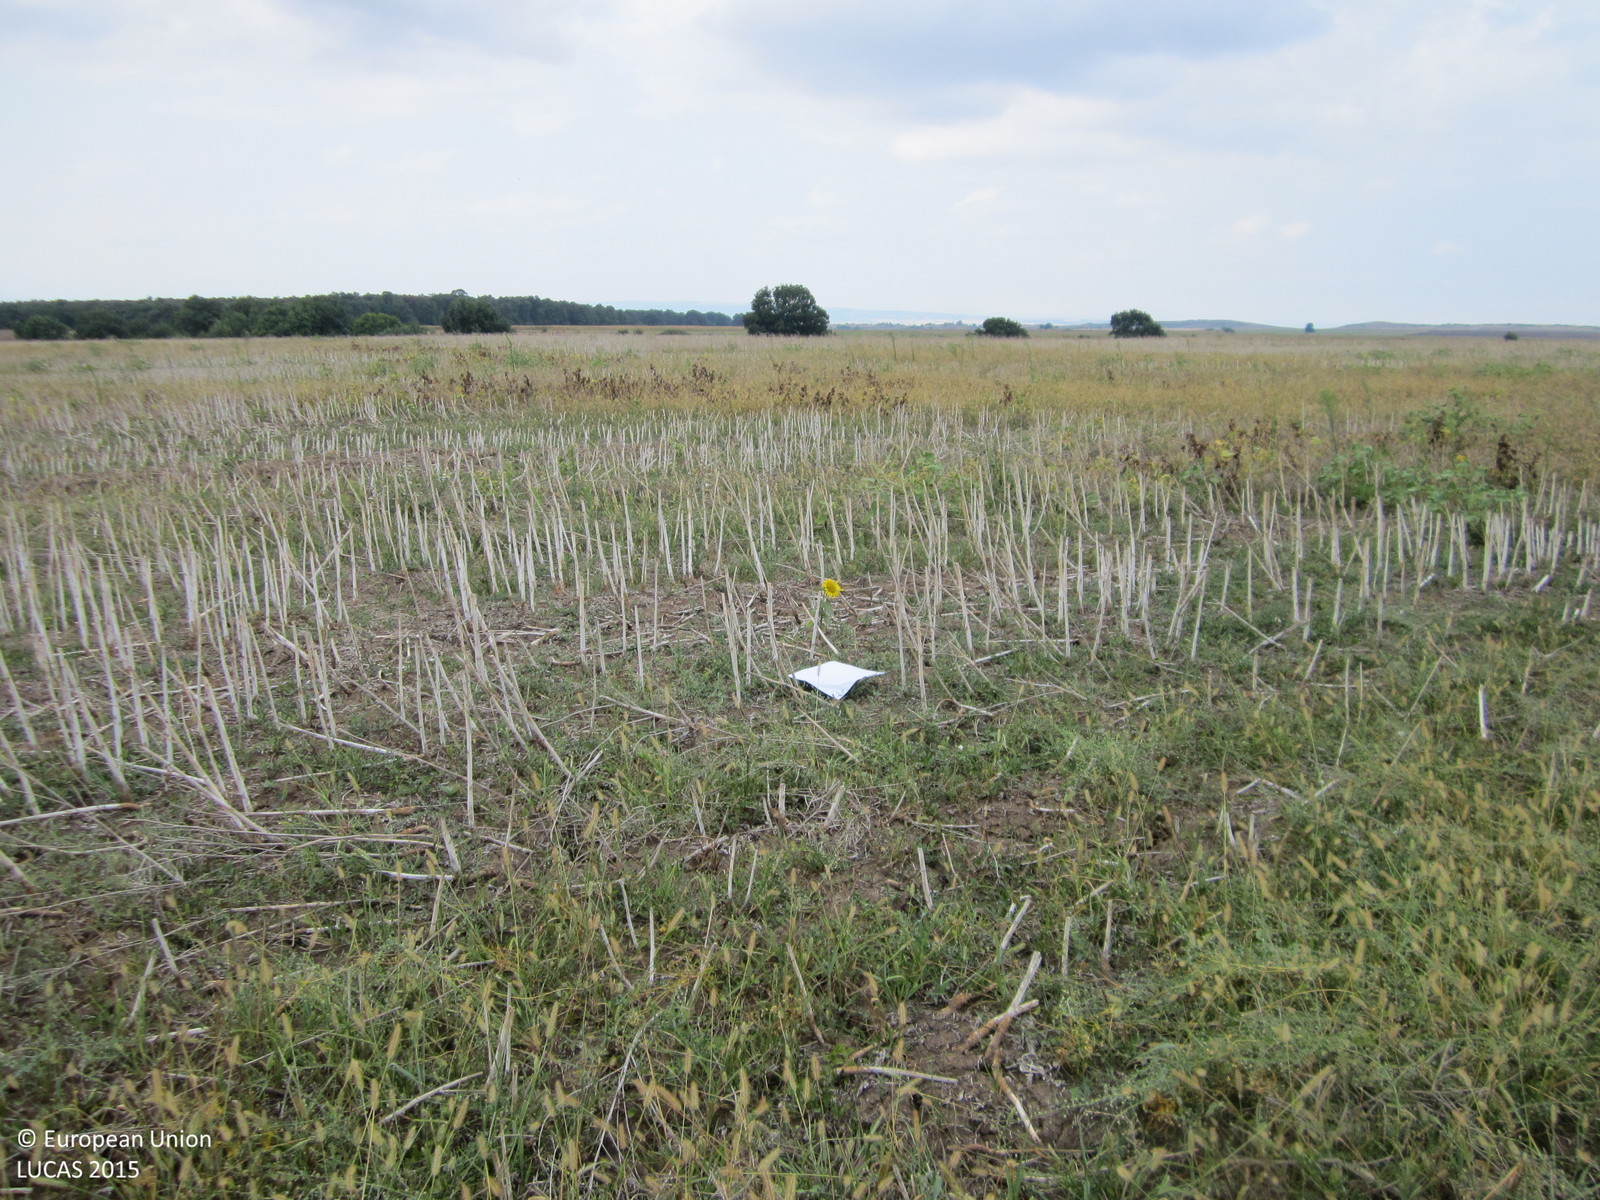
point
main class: Cropland
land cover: Sunflower
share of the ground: 25 - 50 %
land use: Agriculture (excluding fallow land and kitchen gardens)
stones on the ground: < 10 %
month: August
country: BG
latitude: 42.5384
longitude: 26.8432
